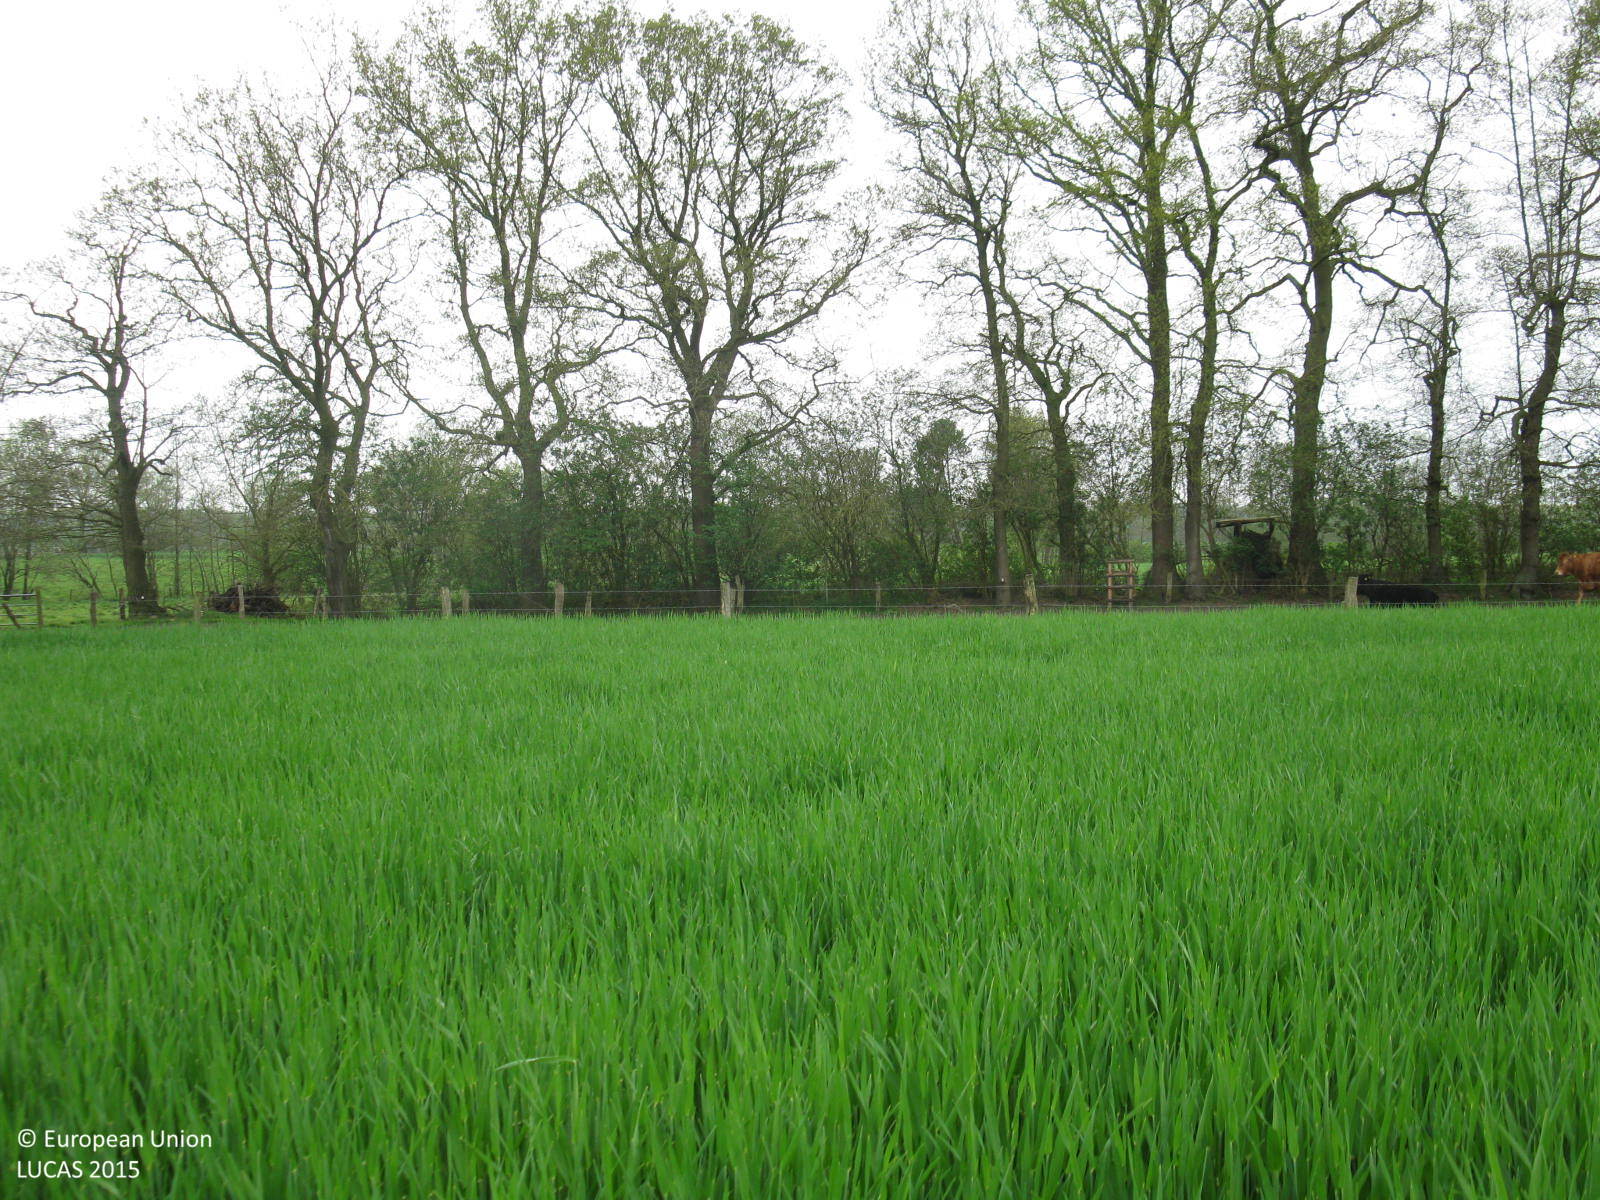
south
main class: Cropland
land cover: Barley
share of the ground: > 75 %
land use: Agriculture (excluding fallow land and kitchen gardens)
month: May
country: DE
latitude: 52.8809
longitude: 7.9351
